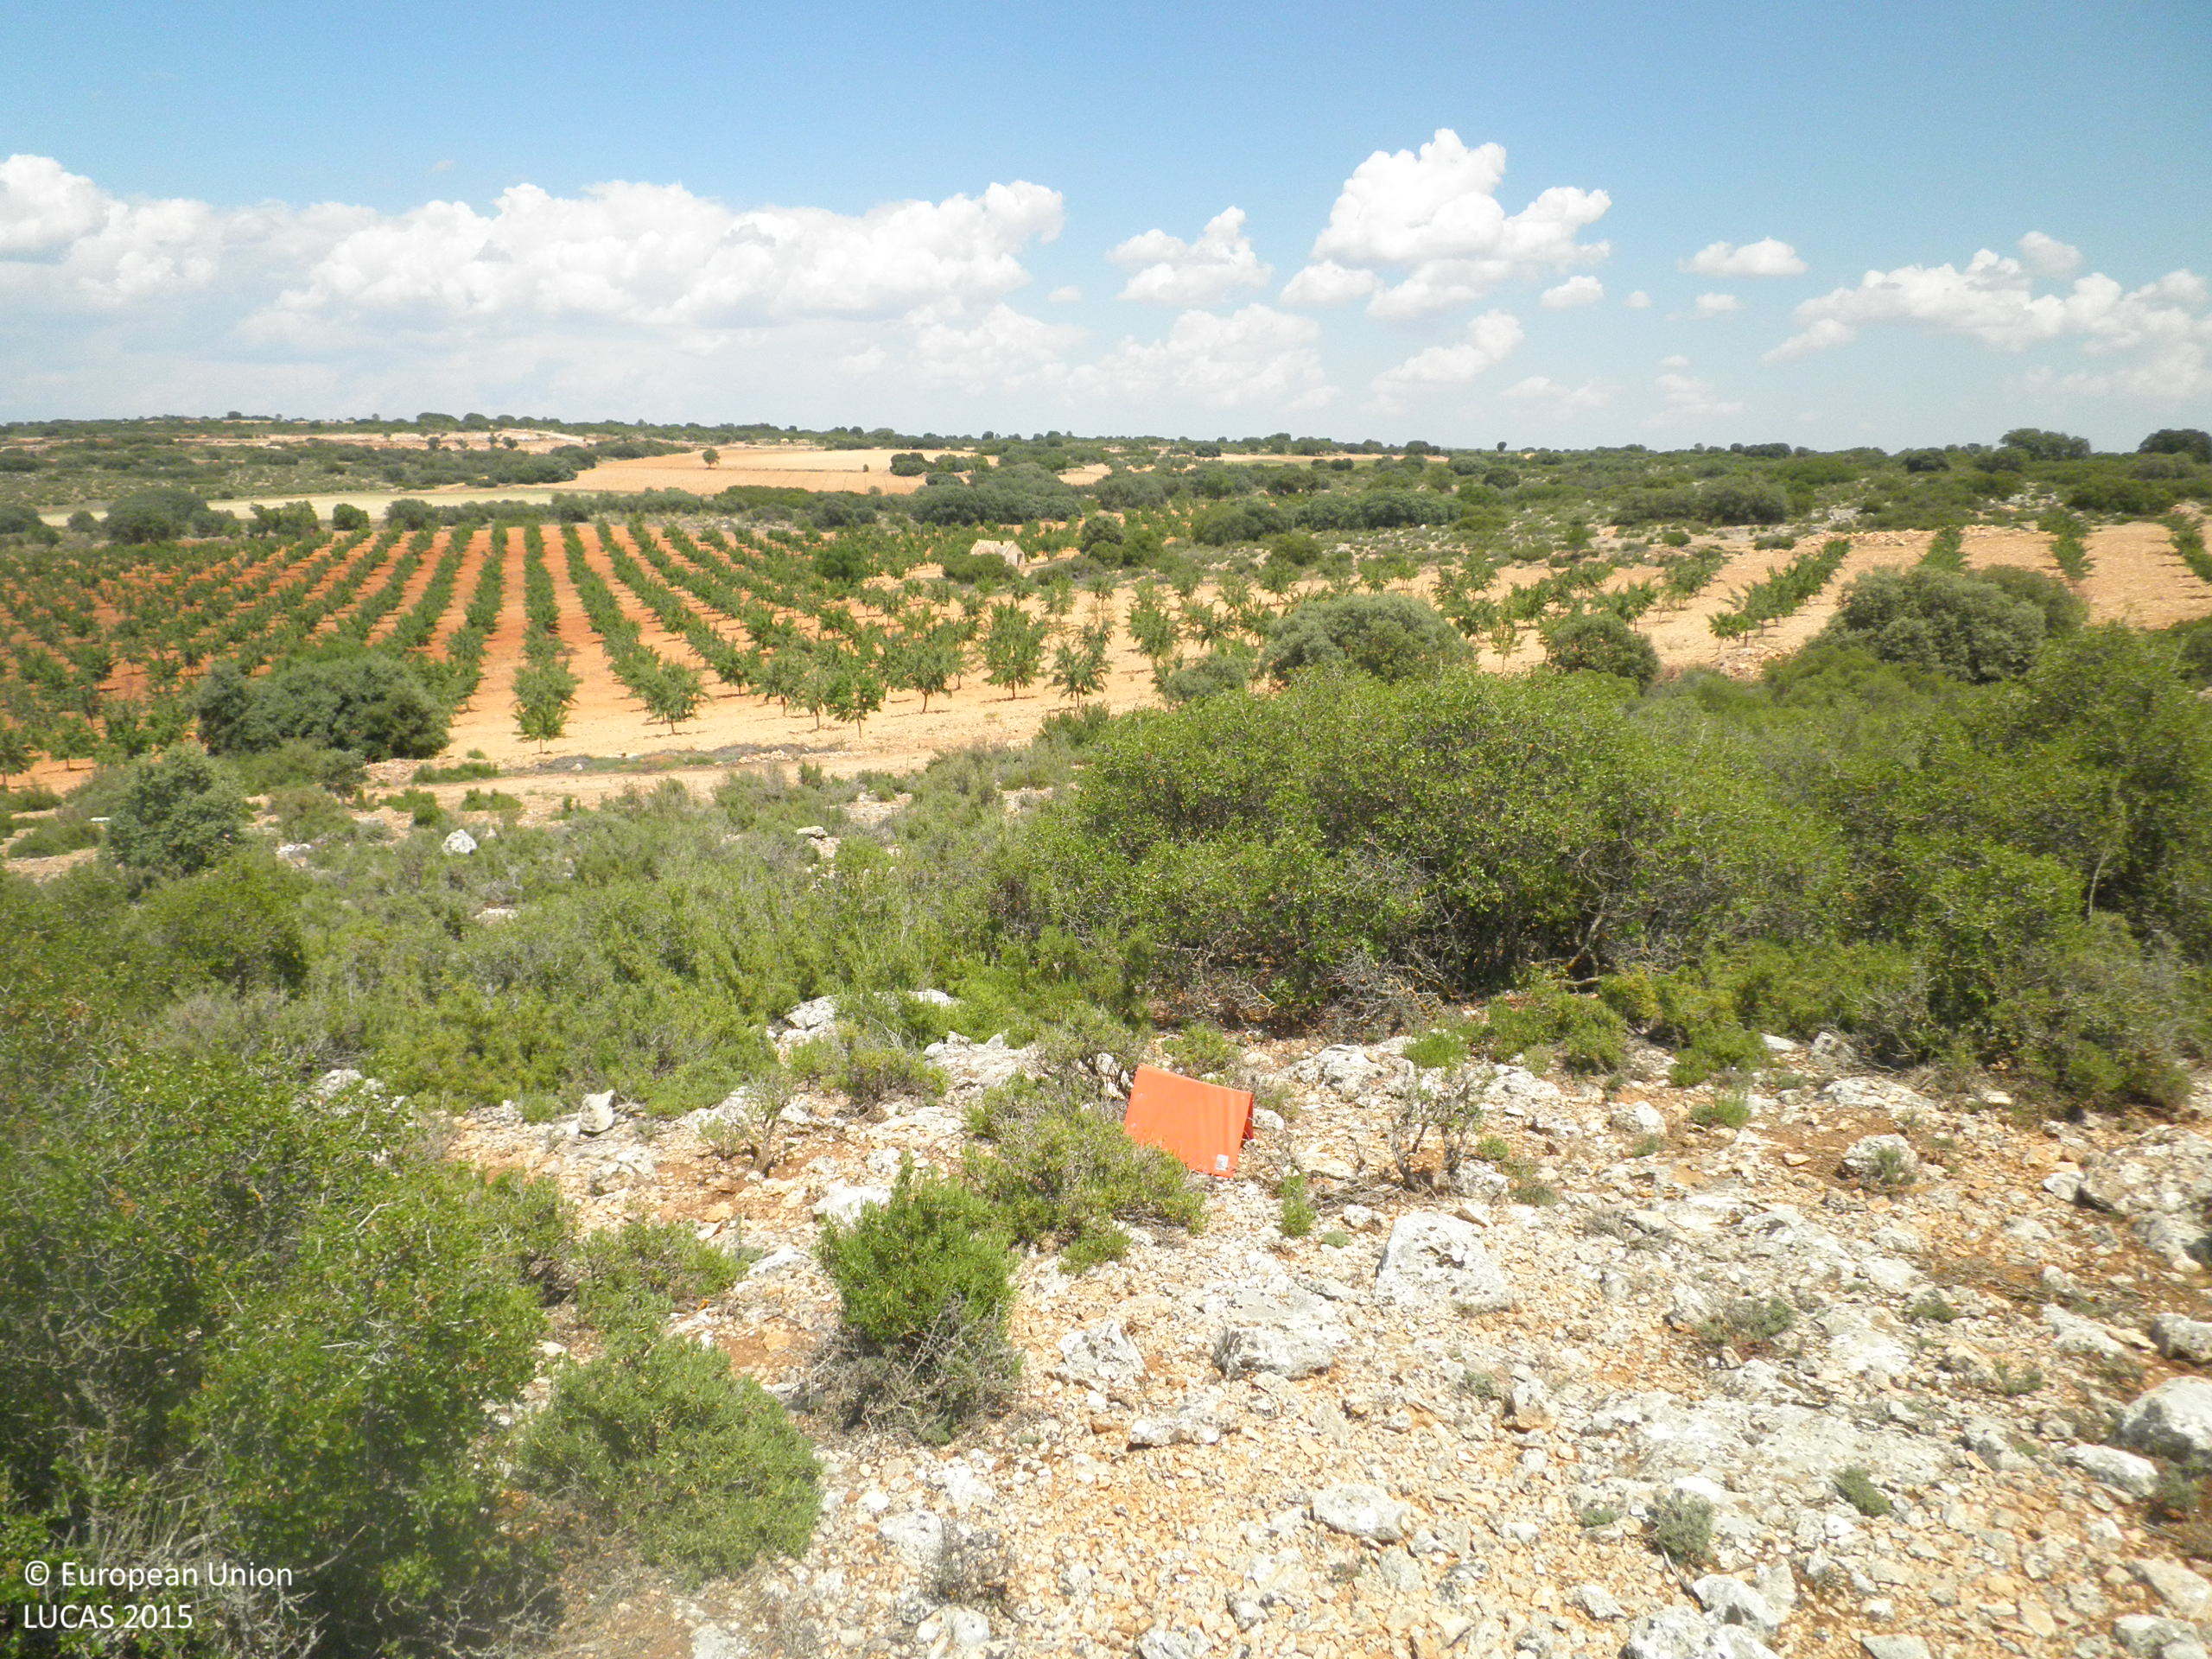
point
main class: Shrubland
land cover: Shrubland without tree cover
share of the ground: 25 - 50 %
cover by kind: consolidated bare surface 50 %, shrubs 40 %, unconsolidated bare surface 10 %
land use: Semi-natural and natural areas not in use
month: June
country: ES
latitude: 39.4844
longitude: -1.7599
